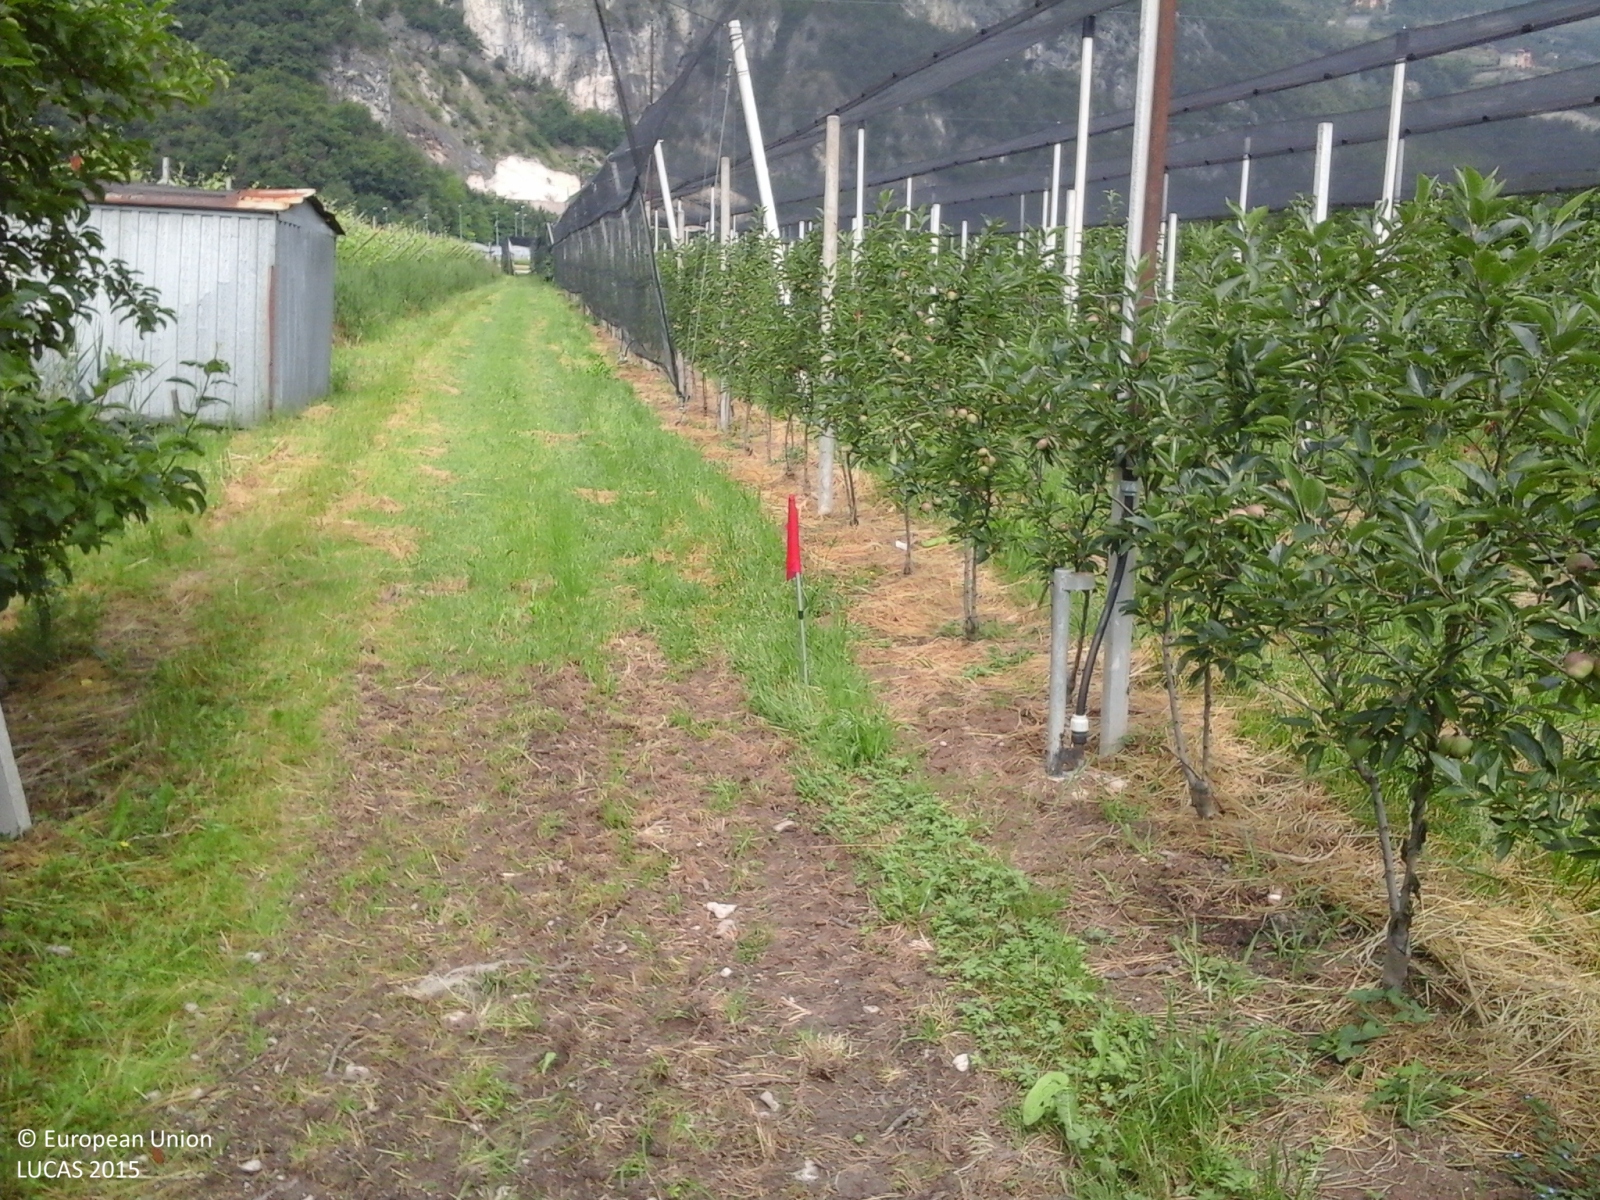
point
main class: Cropland
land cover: Apple fruit
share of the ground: < 10 %
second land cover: Grassland without tree/shrub cover
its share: > 75 %
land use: Agriculture (excluding fallow land and kitchen gardens)
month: June
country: IT
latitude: 45.9673
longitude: 11.0953
